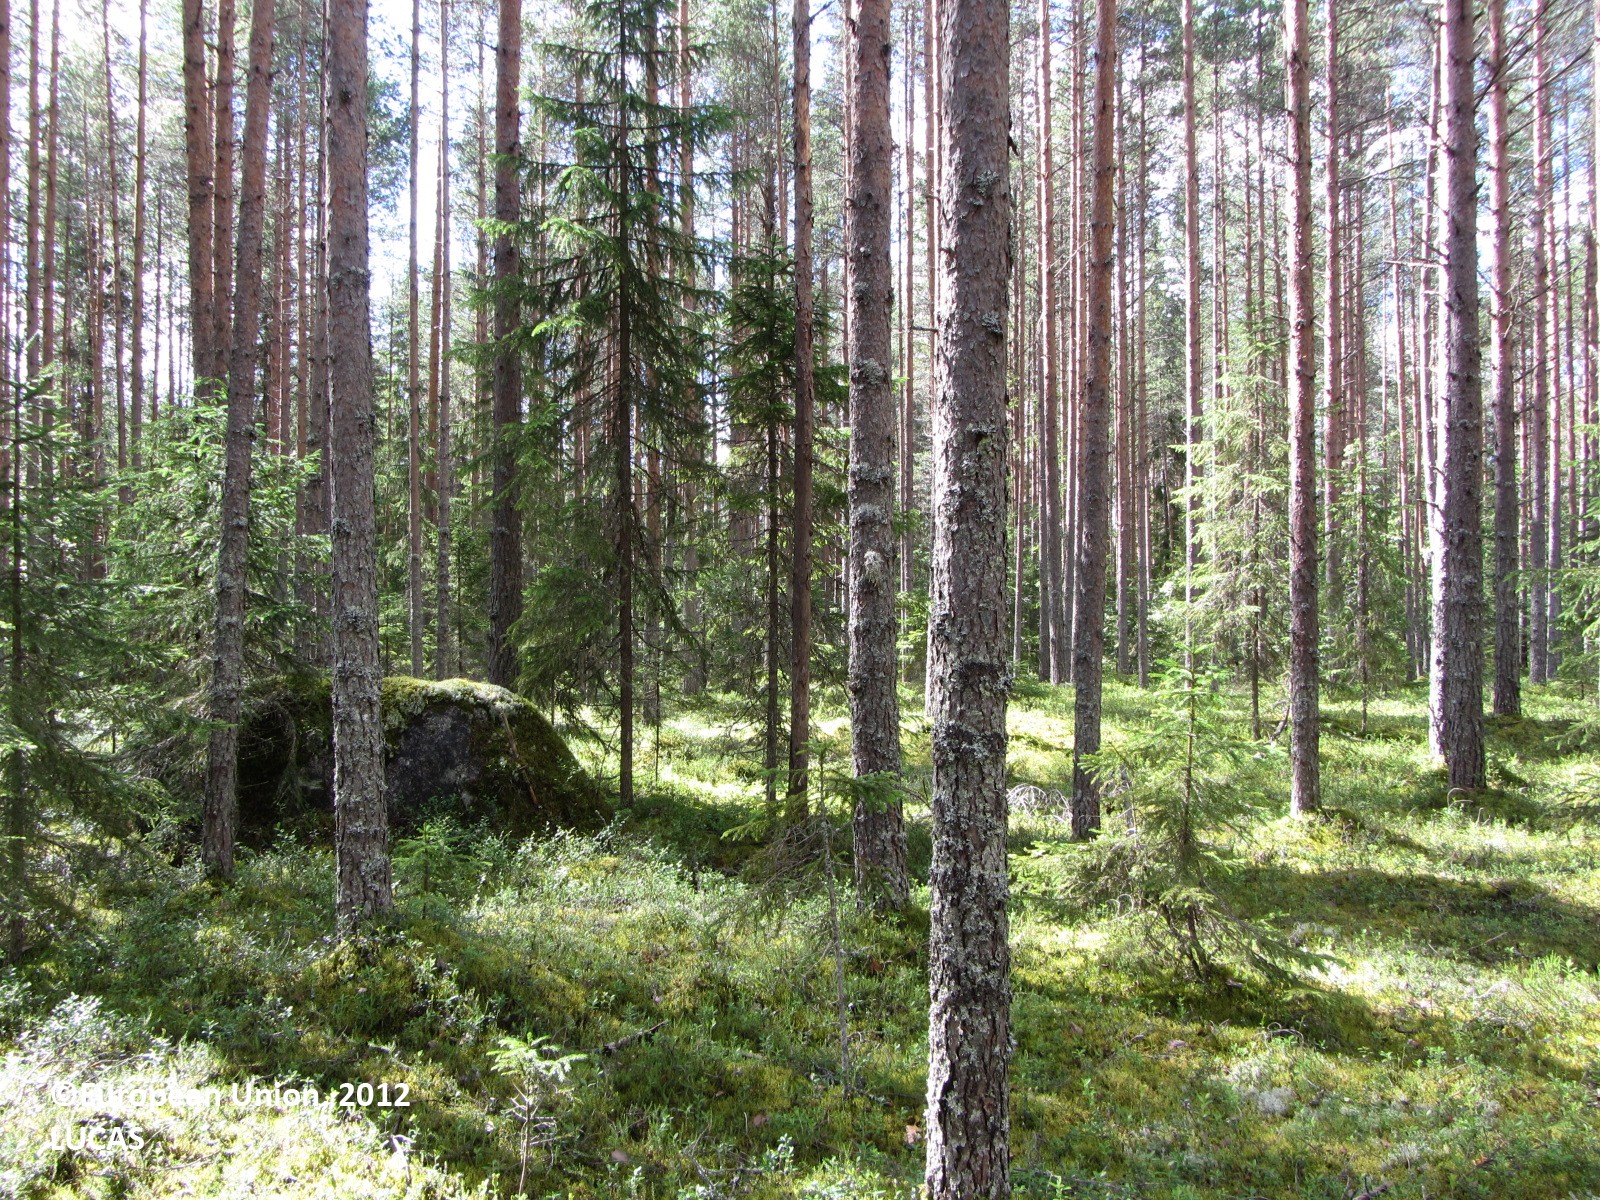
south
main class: Woodland
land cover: Pine dominated coniferous woodland
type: boreal forest
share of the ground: 50 - 75 %
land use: Forestry
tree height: > 5 m
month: July
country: FI
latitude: 63.6436
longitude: 25.5456
